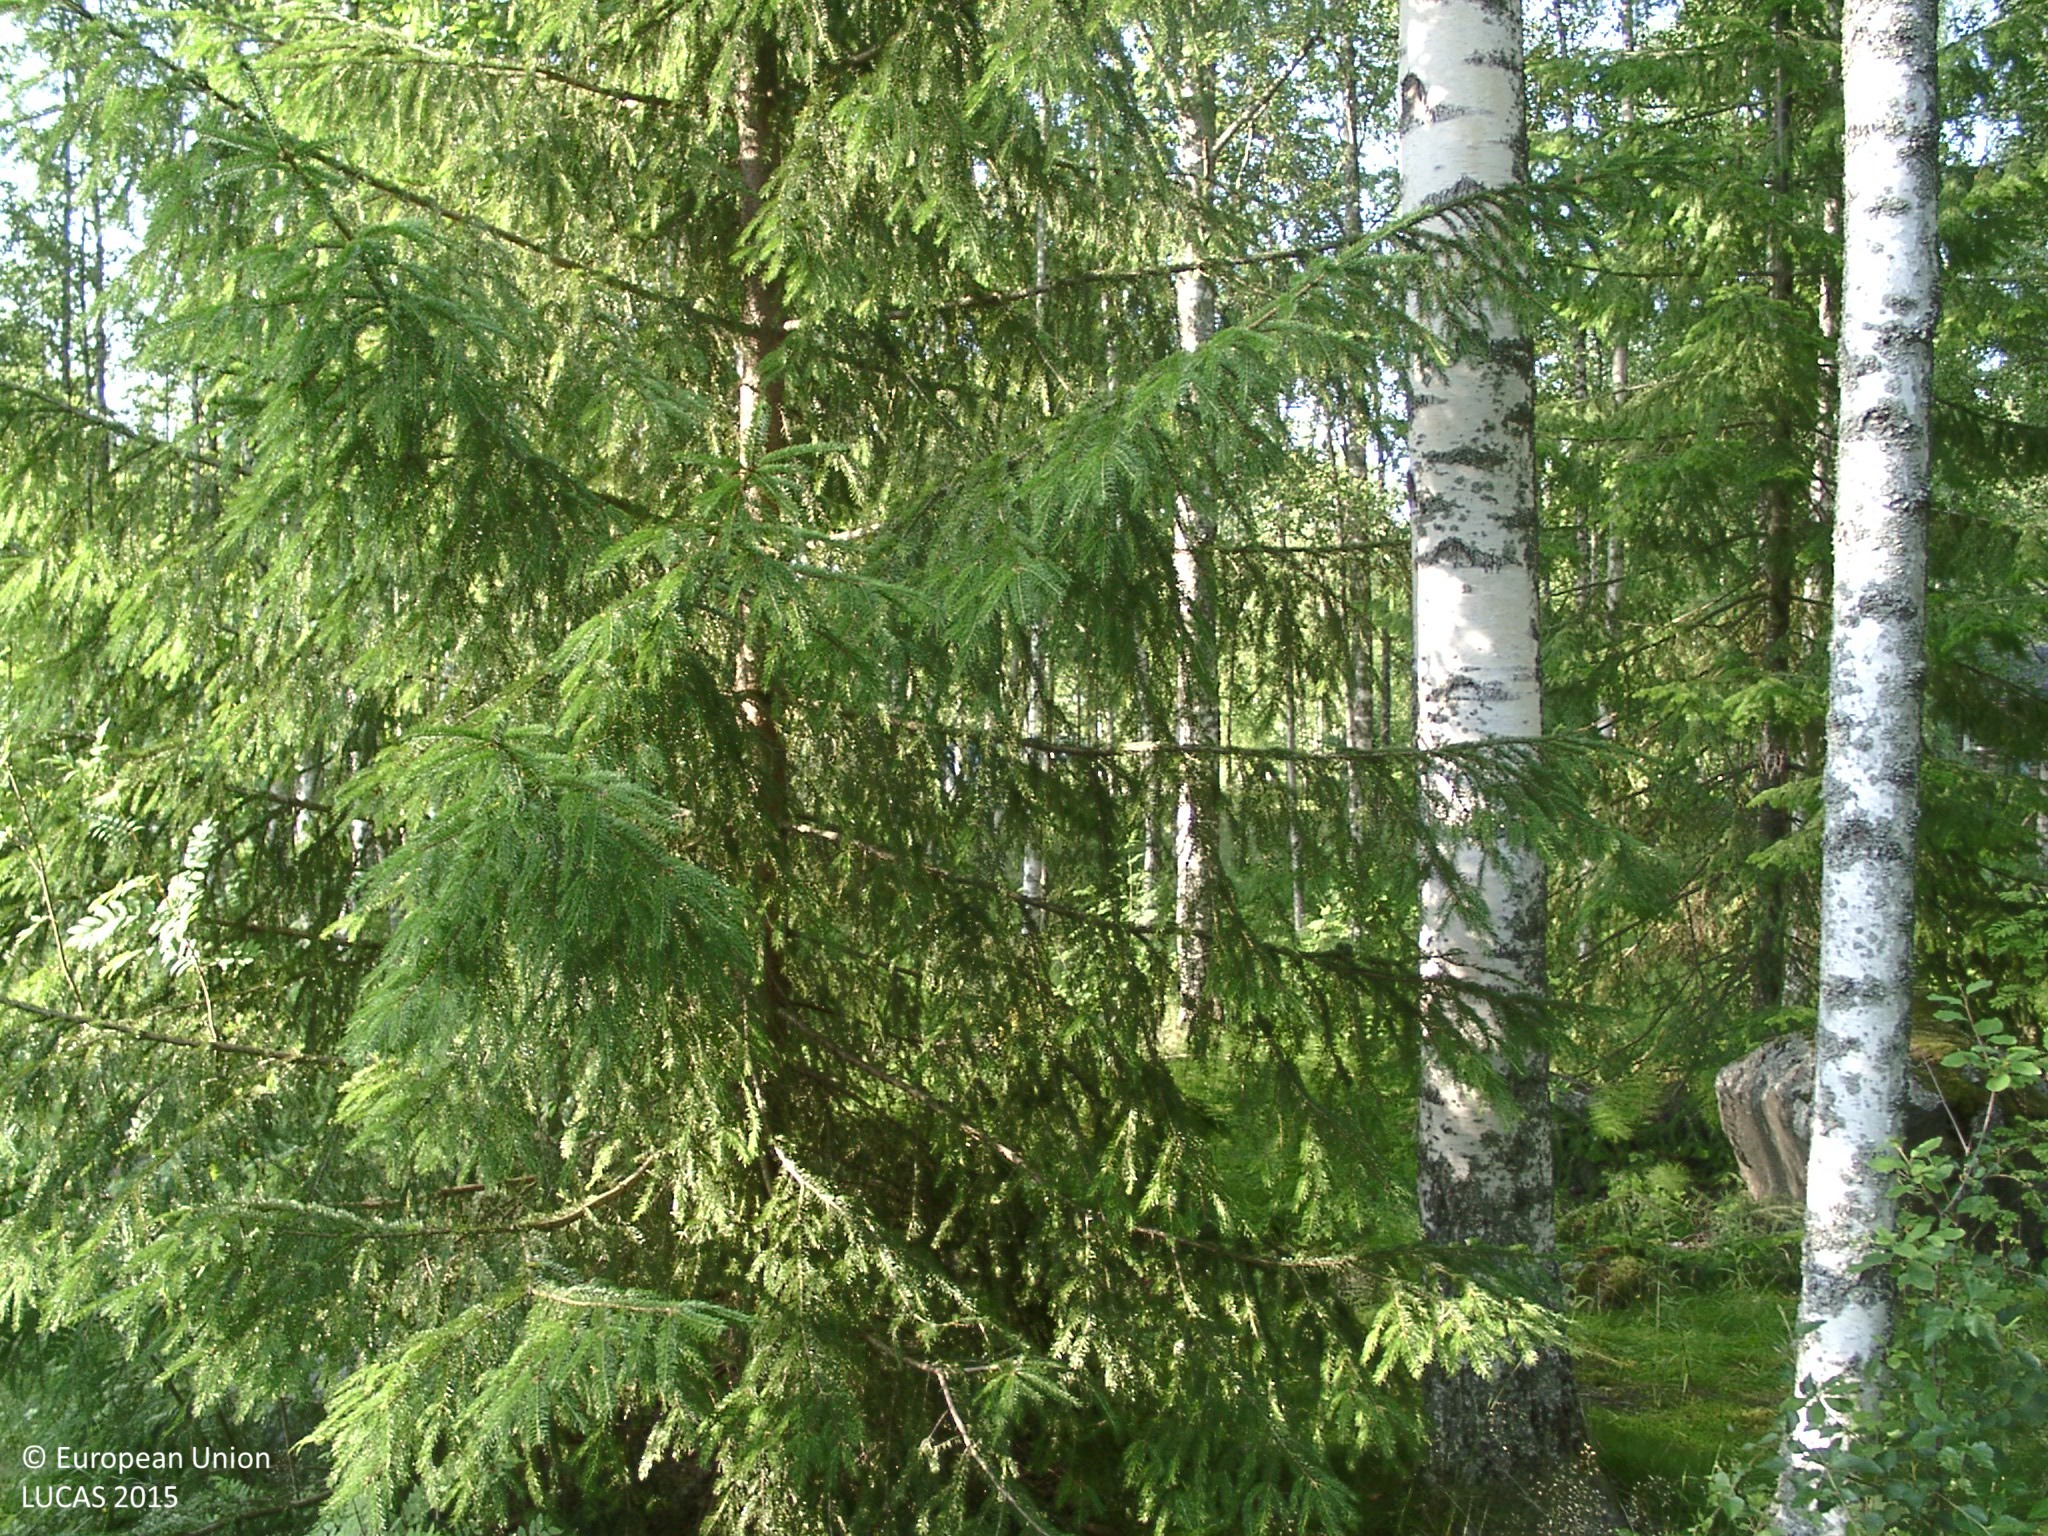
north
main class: Woodland
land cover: Broadleaved woodland
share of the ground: > 75 %
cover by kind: broadleaved forest trees 70 %, herbaceous plants 25 %, coniferous forest trees 5 %
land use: Residential
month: July
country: FI
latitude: 61.5587
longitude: 25.1898
